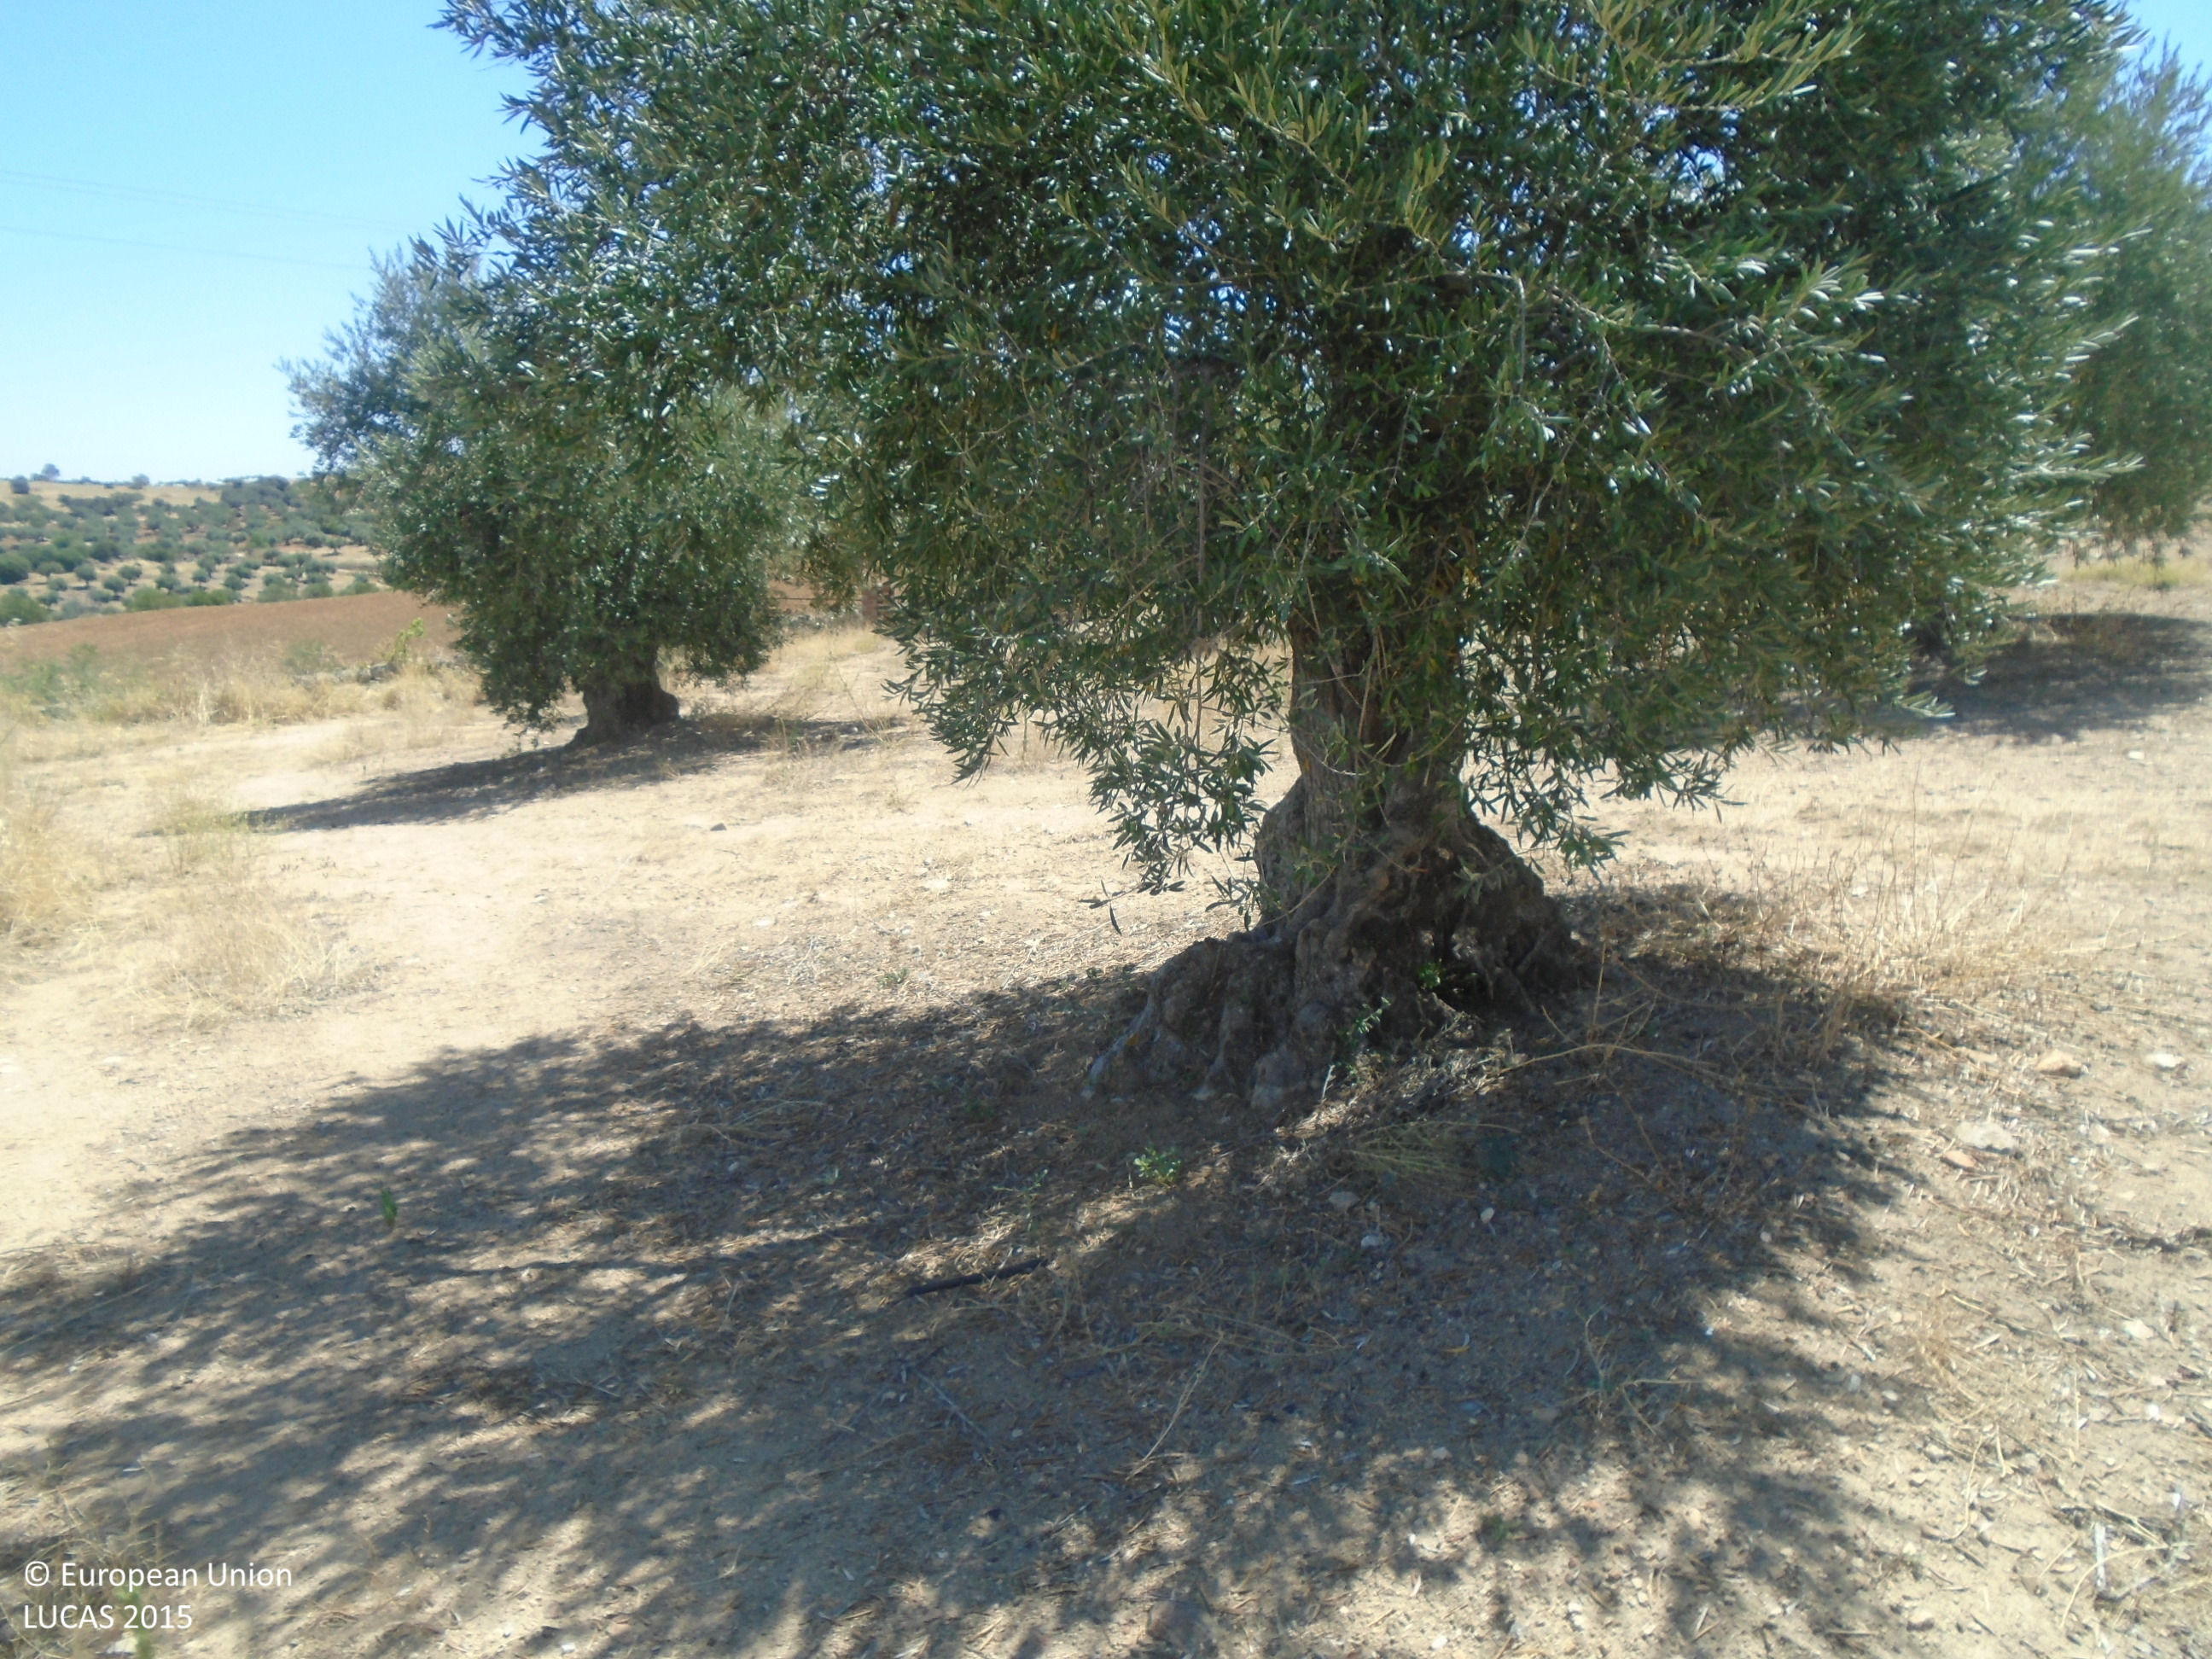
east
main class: Cropland
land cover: Olive groves
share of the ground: 10 - 25 %
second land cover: Spontaneously vegetated surfaces
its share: > 75 %
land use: Agriculture (excluding fallow land and kitchen gardens)
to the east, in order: Olive groves; Spontaneously vegetated surfaces; Tracks; Fences; Tracks; Electric lines; Tracks; Dry stone walls; Spontaneously vegetated surfaces; Dry stone walls; Spontaneously vegetated surfaces; Tracks; Grass margins; Dry stone walls; Other bare soil
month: July
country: ES
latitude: 39.7642
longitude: -5.0247
